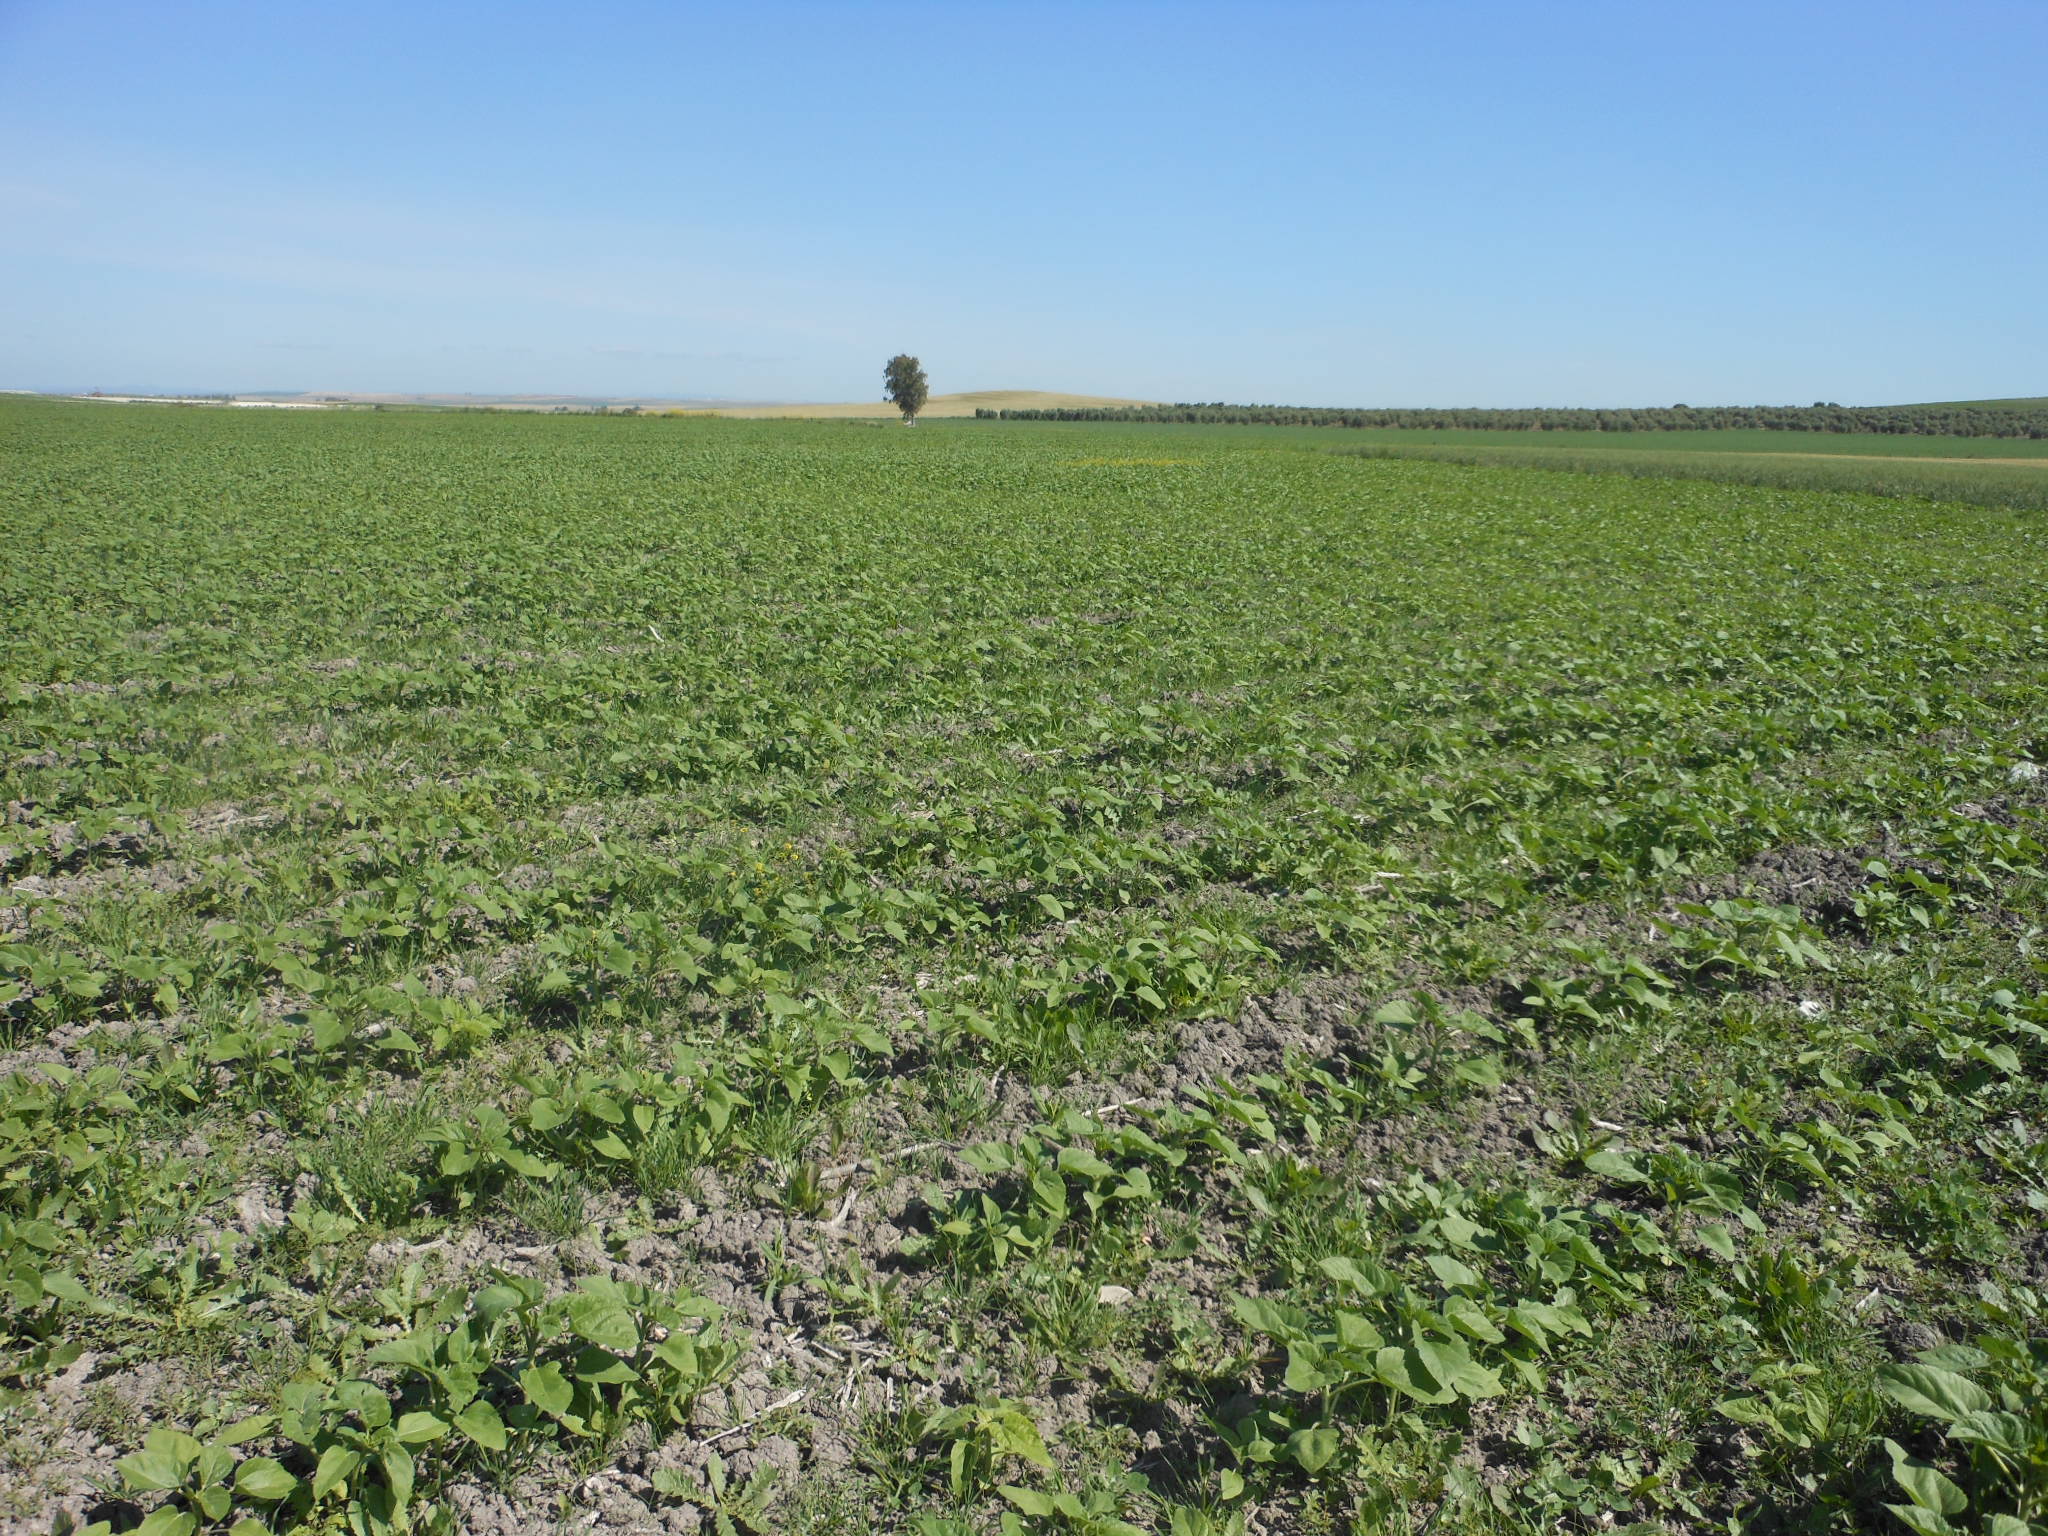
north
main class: Cropland
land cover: Sunflower
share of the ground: 25 - 50 %
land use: Agriculture (excluding fallow land and kitchen gardens)
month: April
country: ES
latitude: 37.3751
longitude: -5.4751
